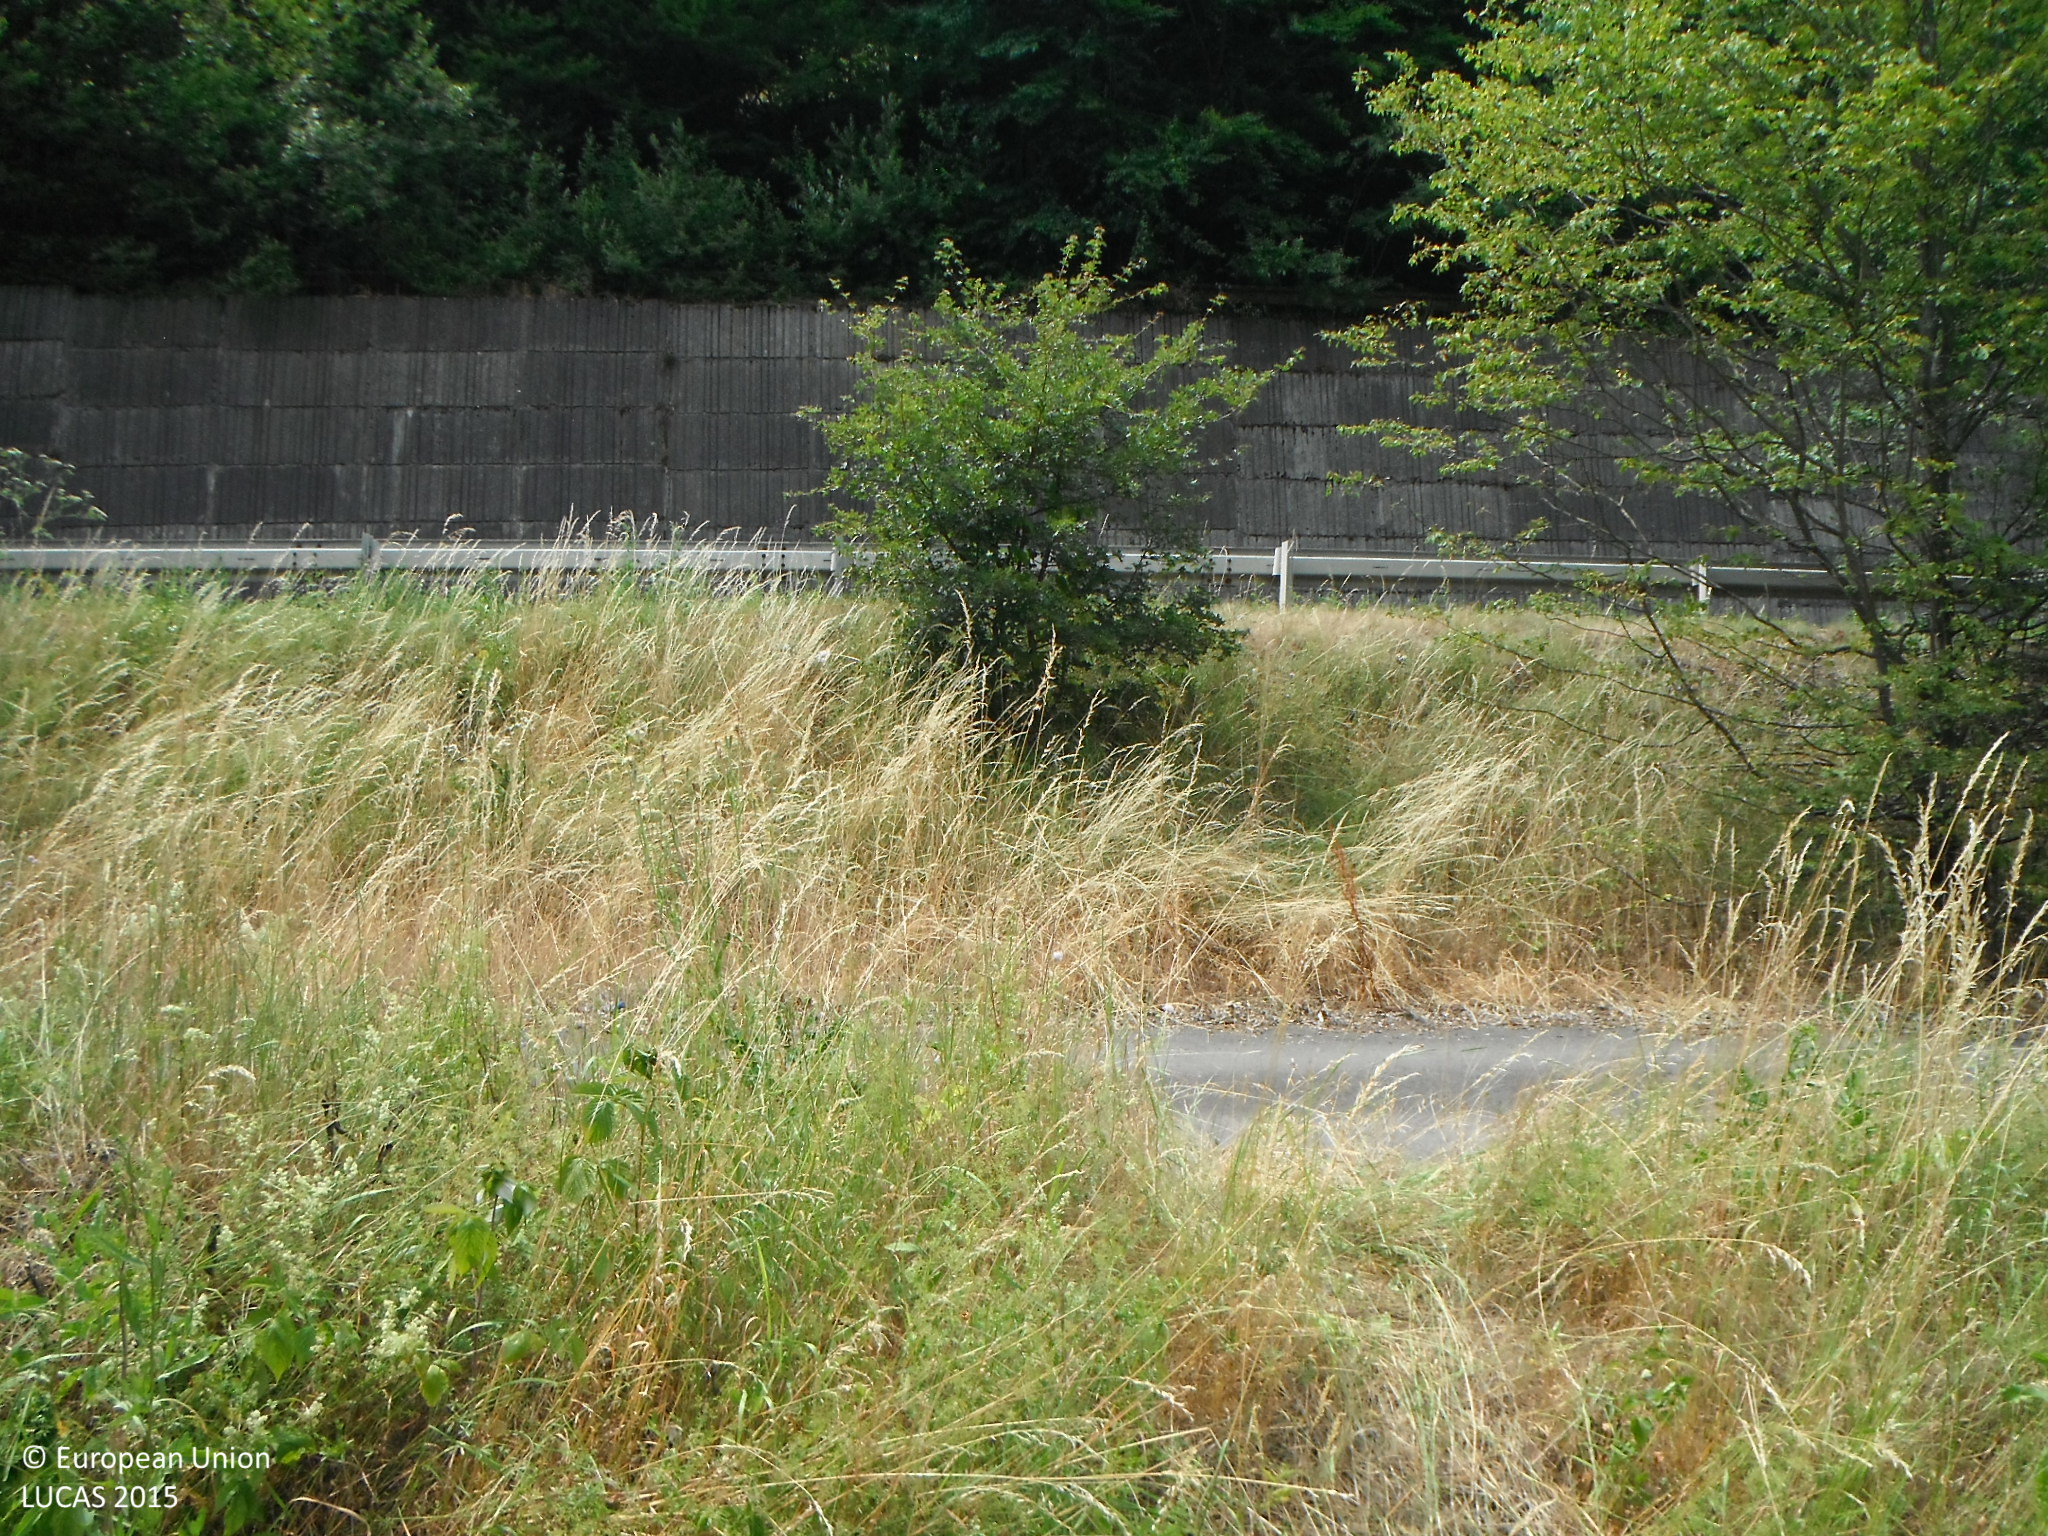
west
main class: Grassland
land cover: Grassland with sparse tree/shrub cover
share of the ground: > 75 %
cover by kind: herbaceous plants 90 %, broadleaved forest trees 5 %, shrubs 5 %
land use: Semi-natural and natural areas not in use
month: July
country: SK
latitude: 48.4090
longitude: 19.0860
